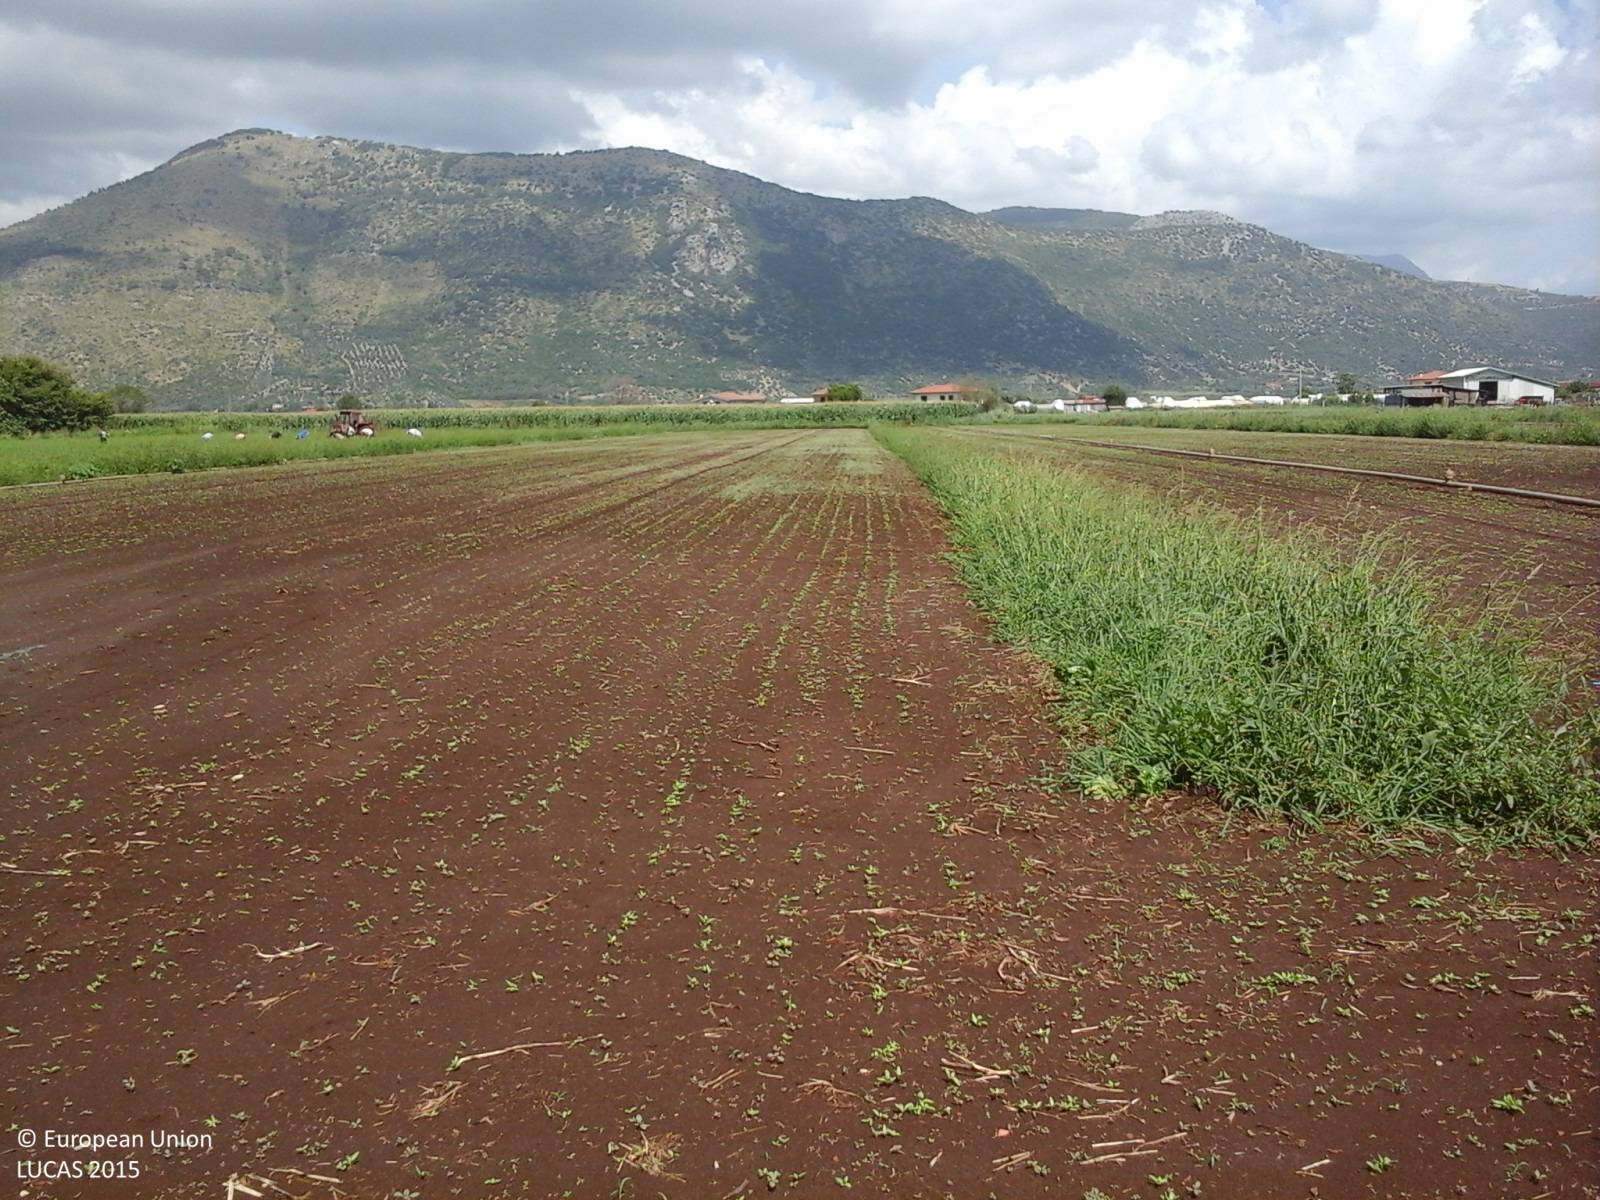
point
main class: Cropland
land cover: Other fresh vegetables
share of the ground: < 10 %
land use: Agriculture (excluding fallow land and kitchen gardens)
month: August
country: IT
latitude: 41.4888
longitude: 12.9945
